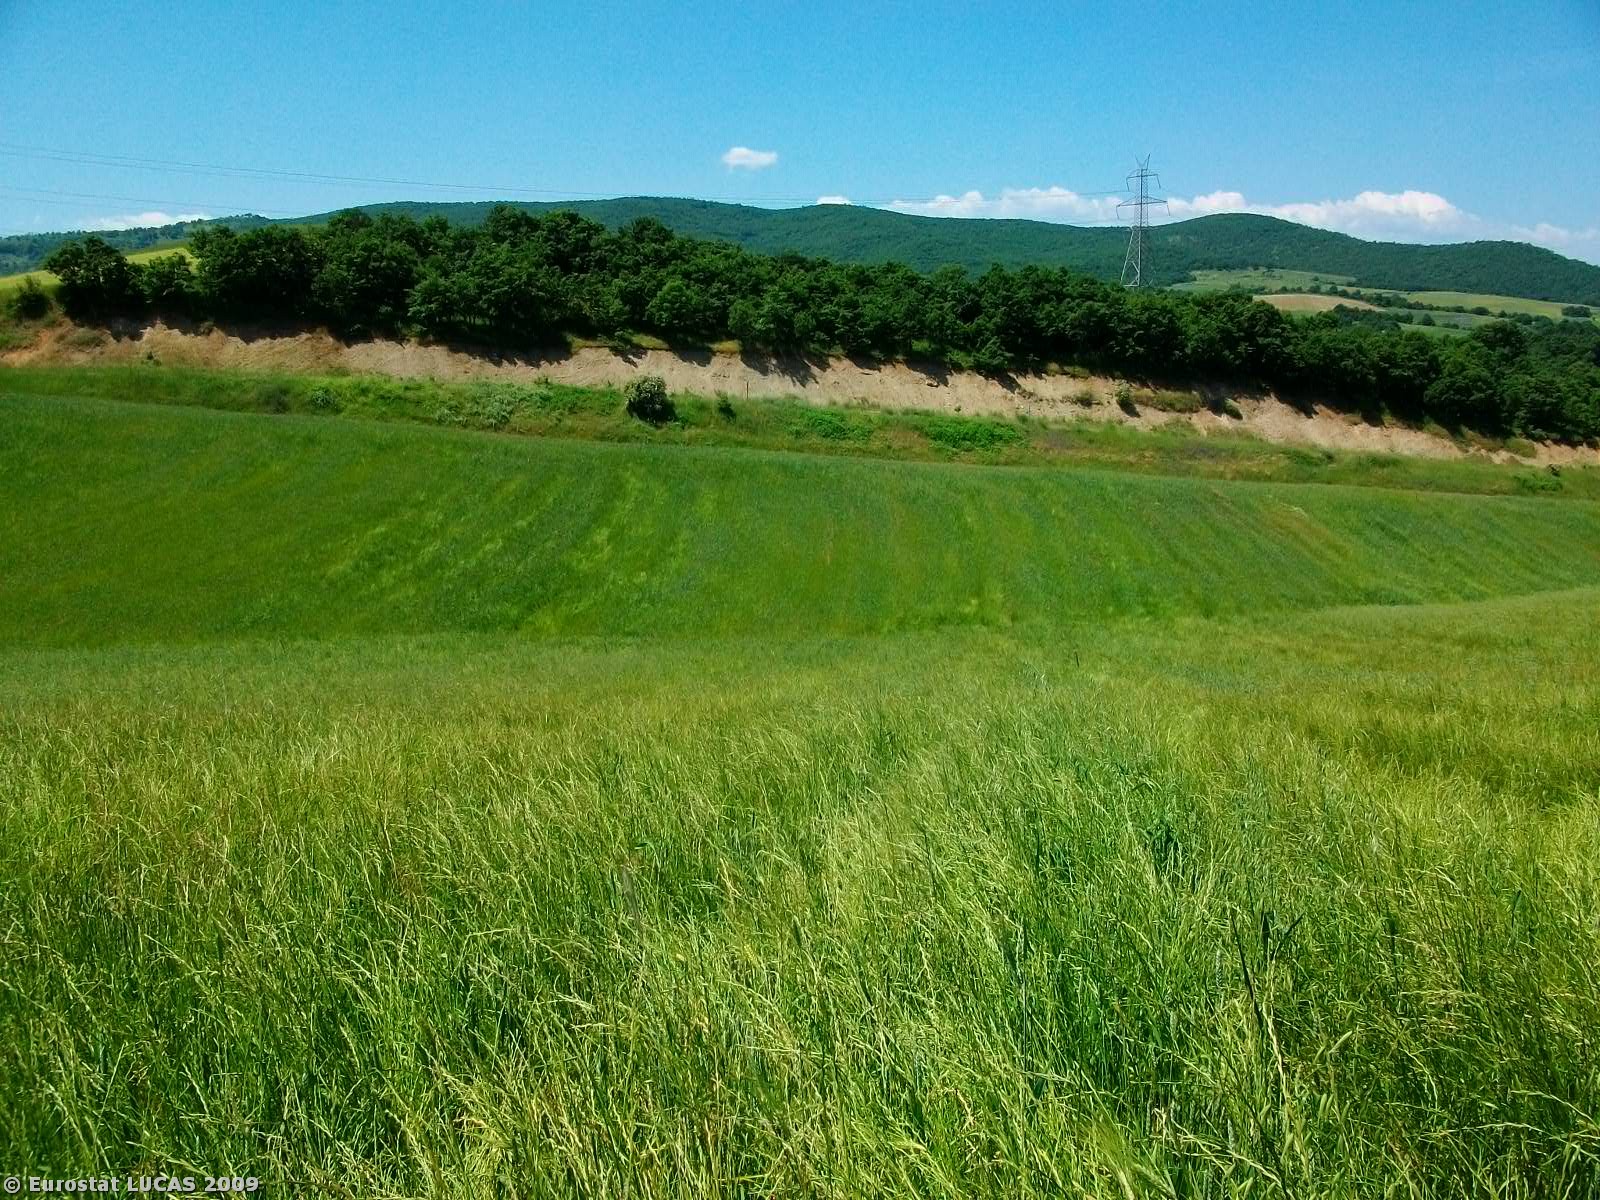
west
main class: Cropland
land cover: Common wheat
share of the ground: > 75 %
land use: Agriculture (excluding fallow land and kitchen gardens)
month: May
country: GR
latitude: 39.8613
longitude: 21.6640
